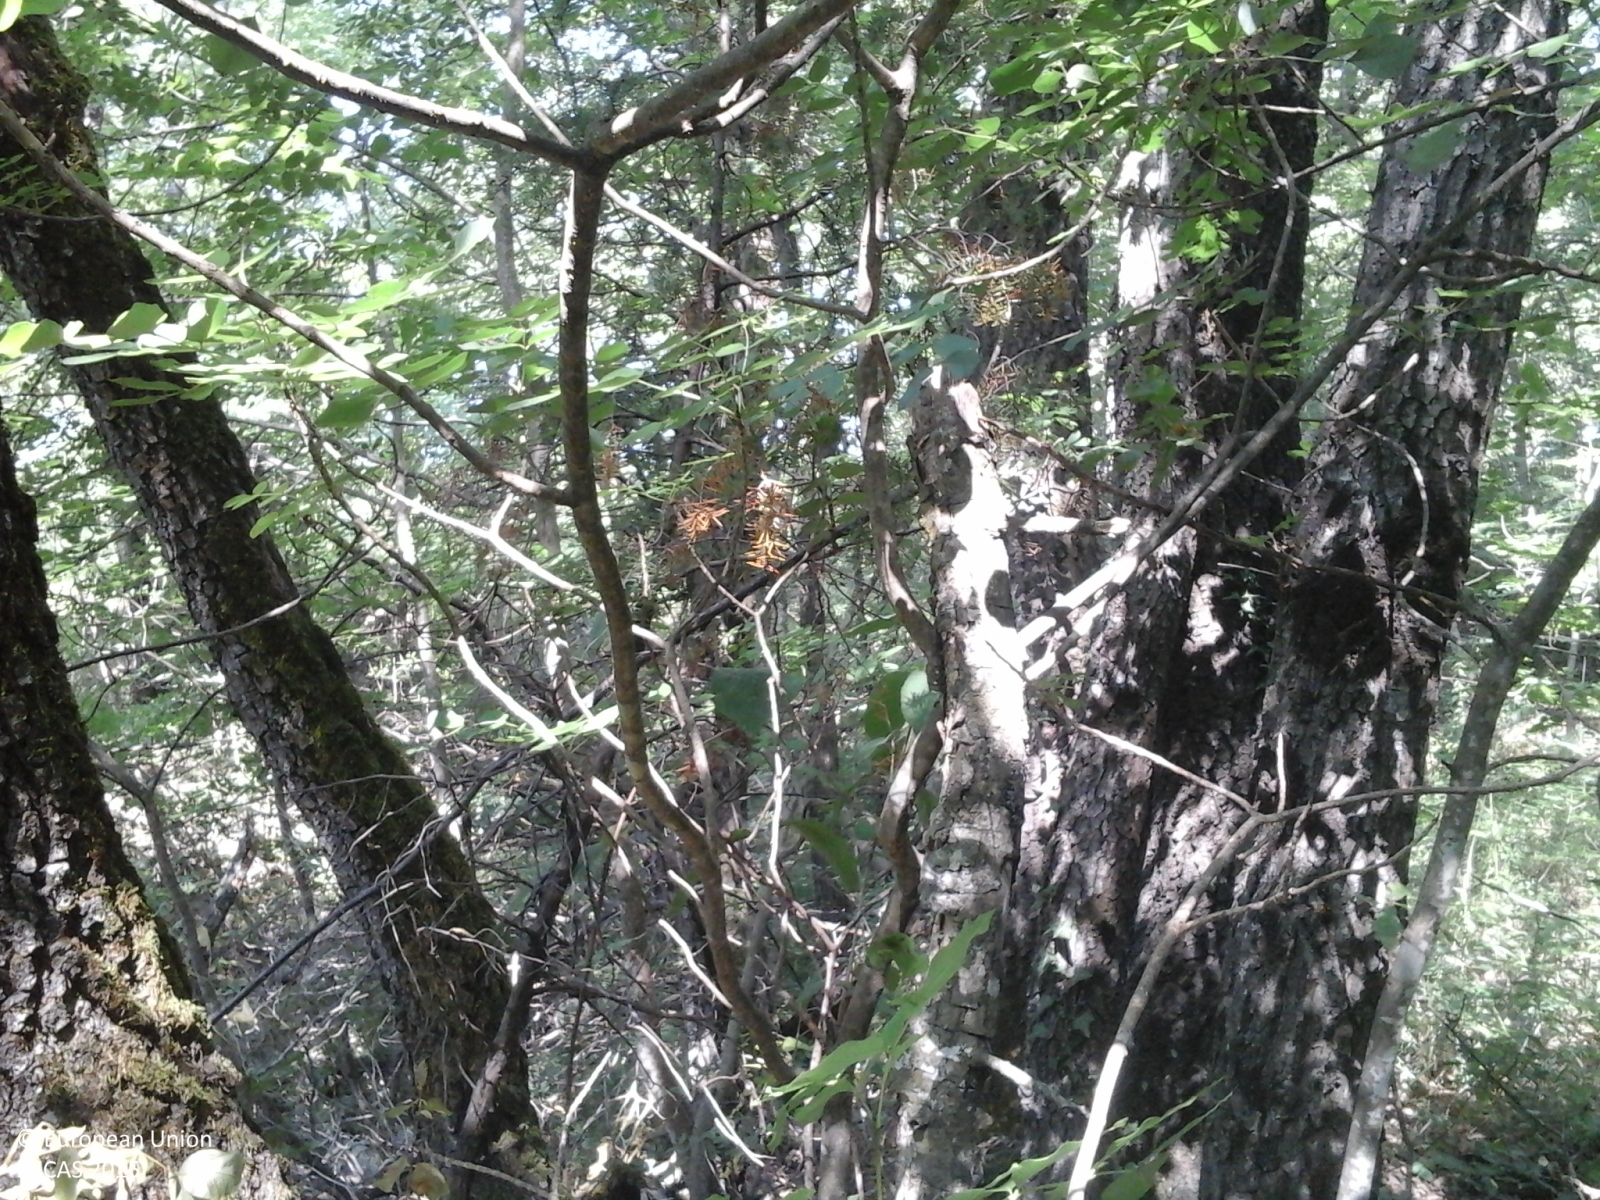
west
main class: Woodland
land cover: Broadleaved woodland
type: thermophilous deciduous forest
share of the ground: > 75 %
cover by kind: broadleaved forest trees 100 %
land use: Forestry
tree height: > 5 m
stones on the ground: < 10 %
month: July
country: IT
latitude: 44.4405
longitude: 10.2382
